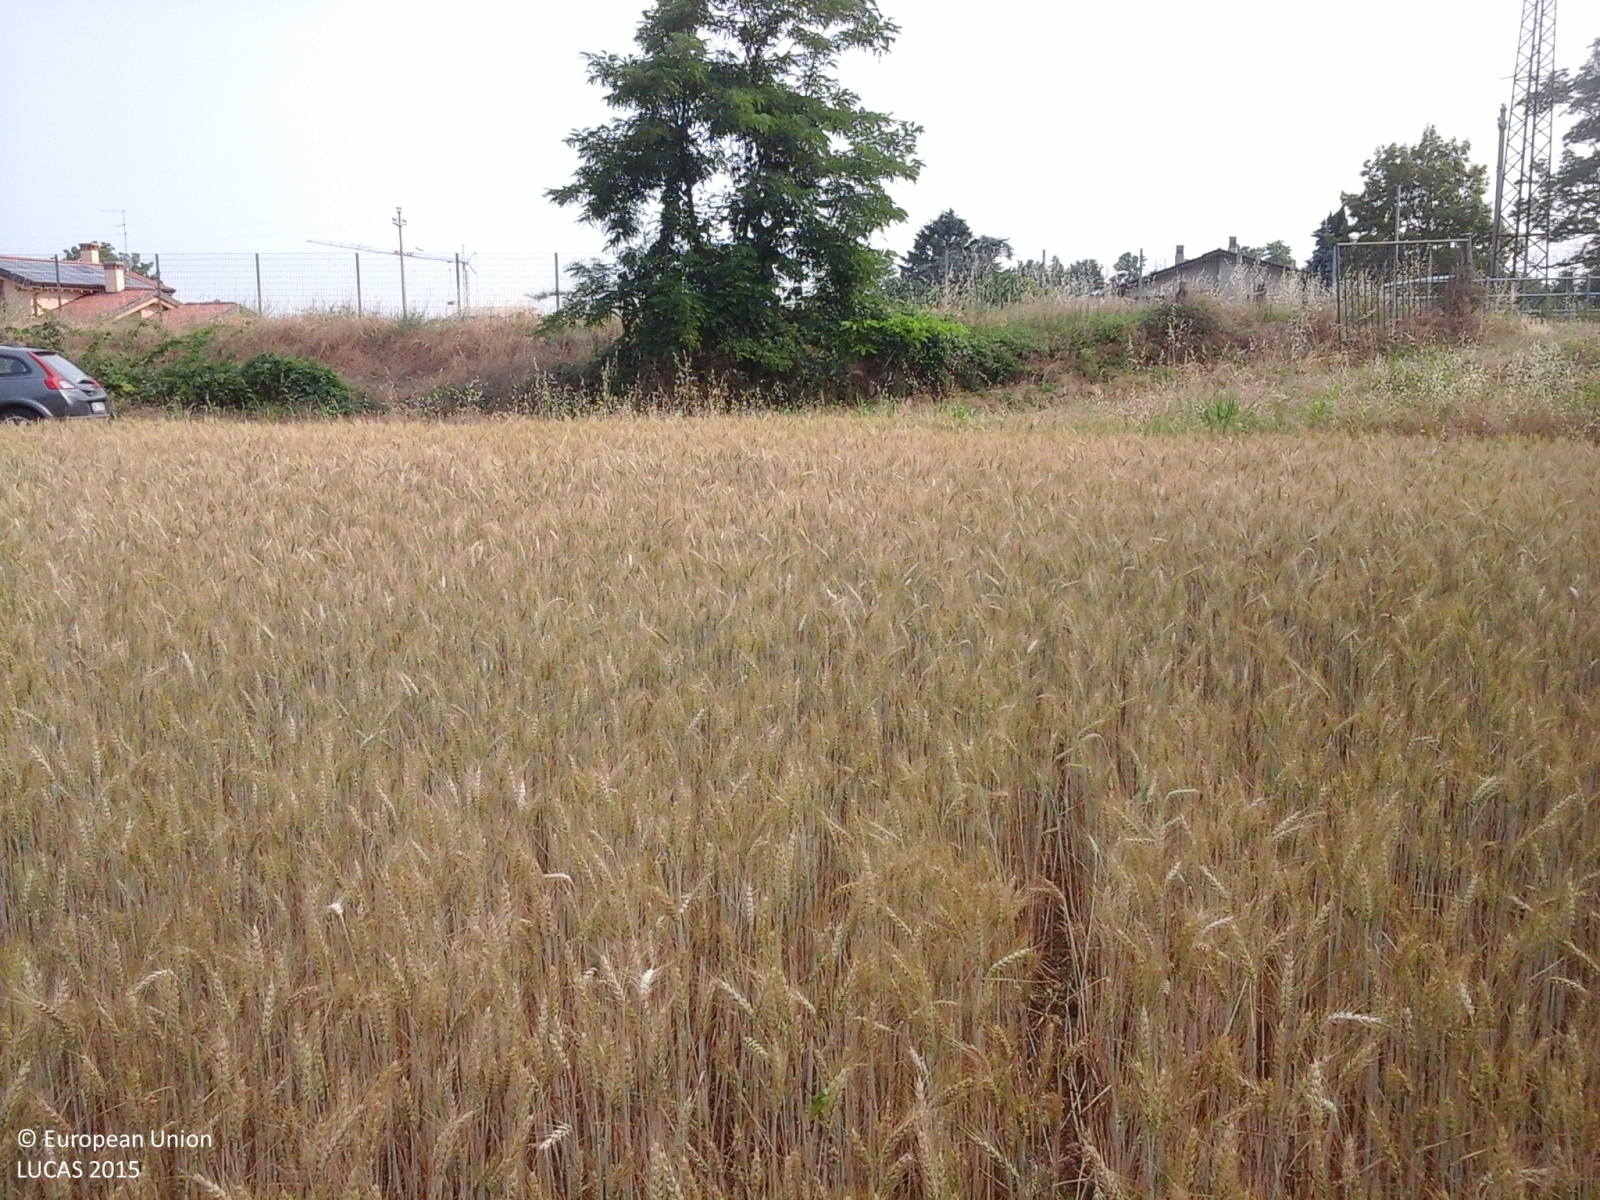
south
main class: Cropland
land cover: Common wheat
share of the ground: > 75 %
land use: Agriculture (excluding fallow land and kitchen gardens)
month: June
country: IT
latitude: 45.4642
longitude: 10.9320
